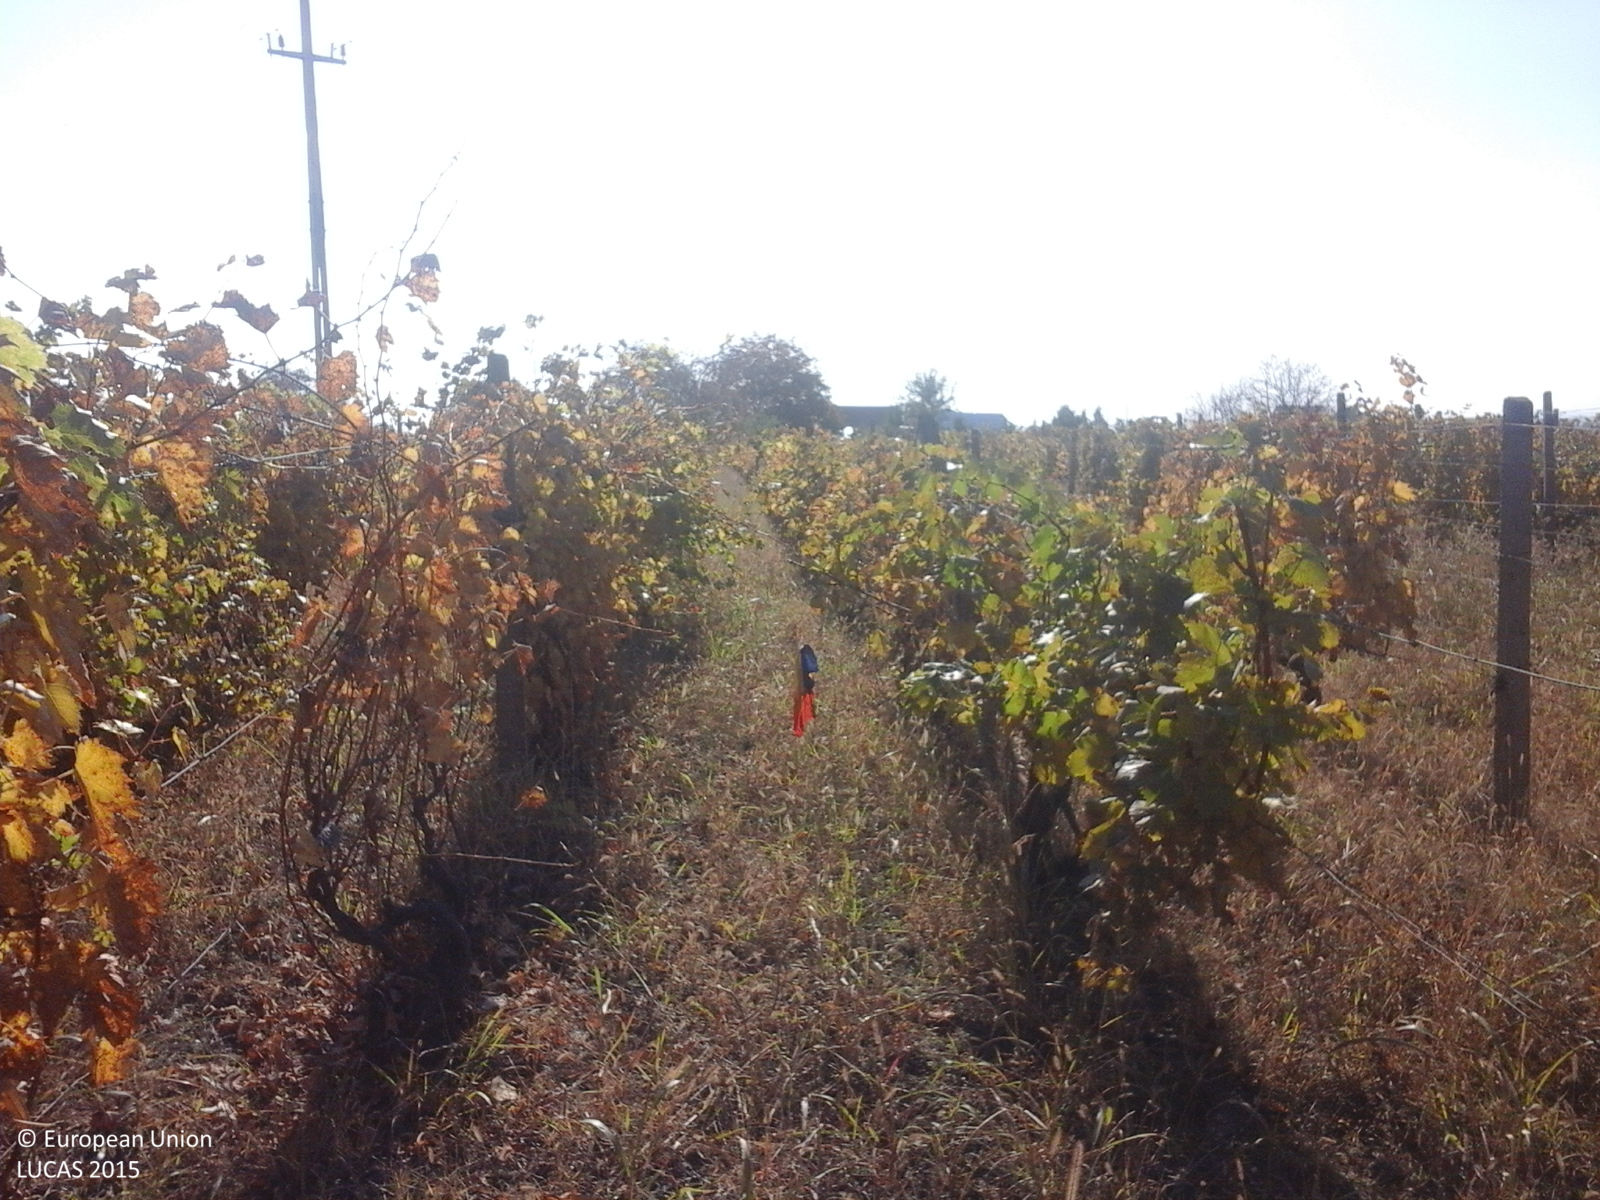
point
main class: Cropland
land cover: Vineyards
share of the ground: > 75 %
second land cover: Grassland without tree/shrub cover
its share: > 75 %
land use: Agriculture (excluding fallow land and kitchen gardens)
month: October
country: RO
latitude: 45.6430
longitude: 27.0917
